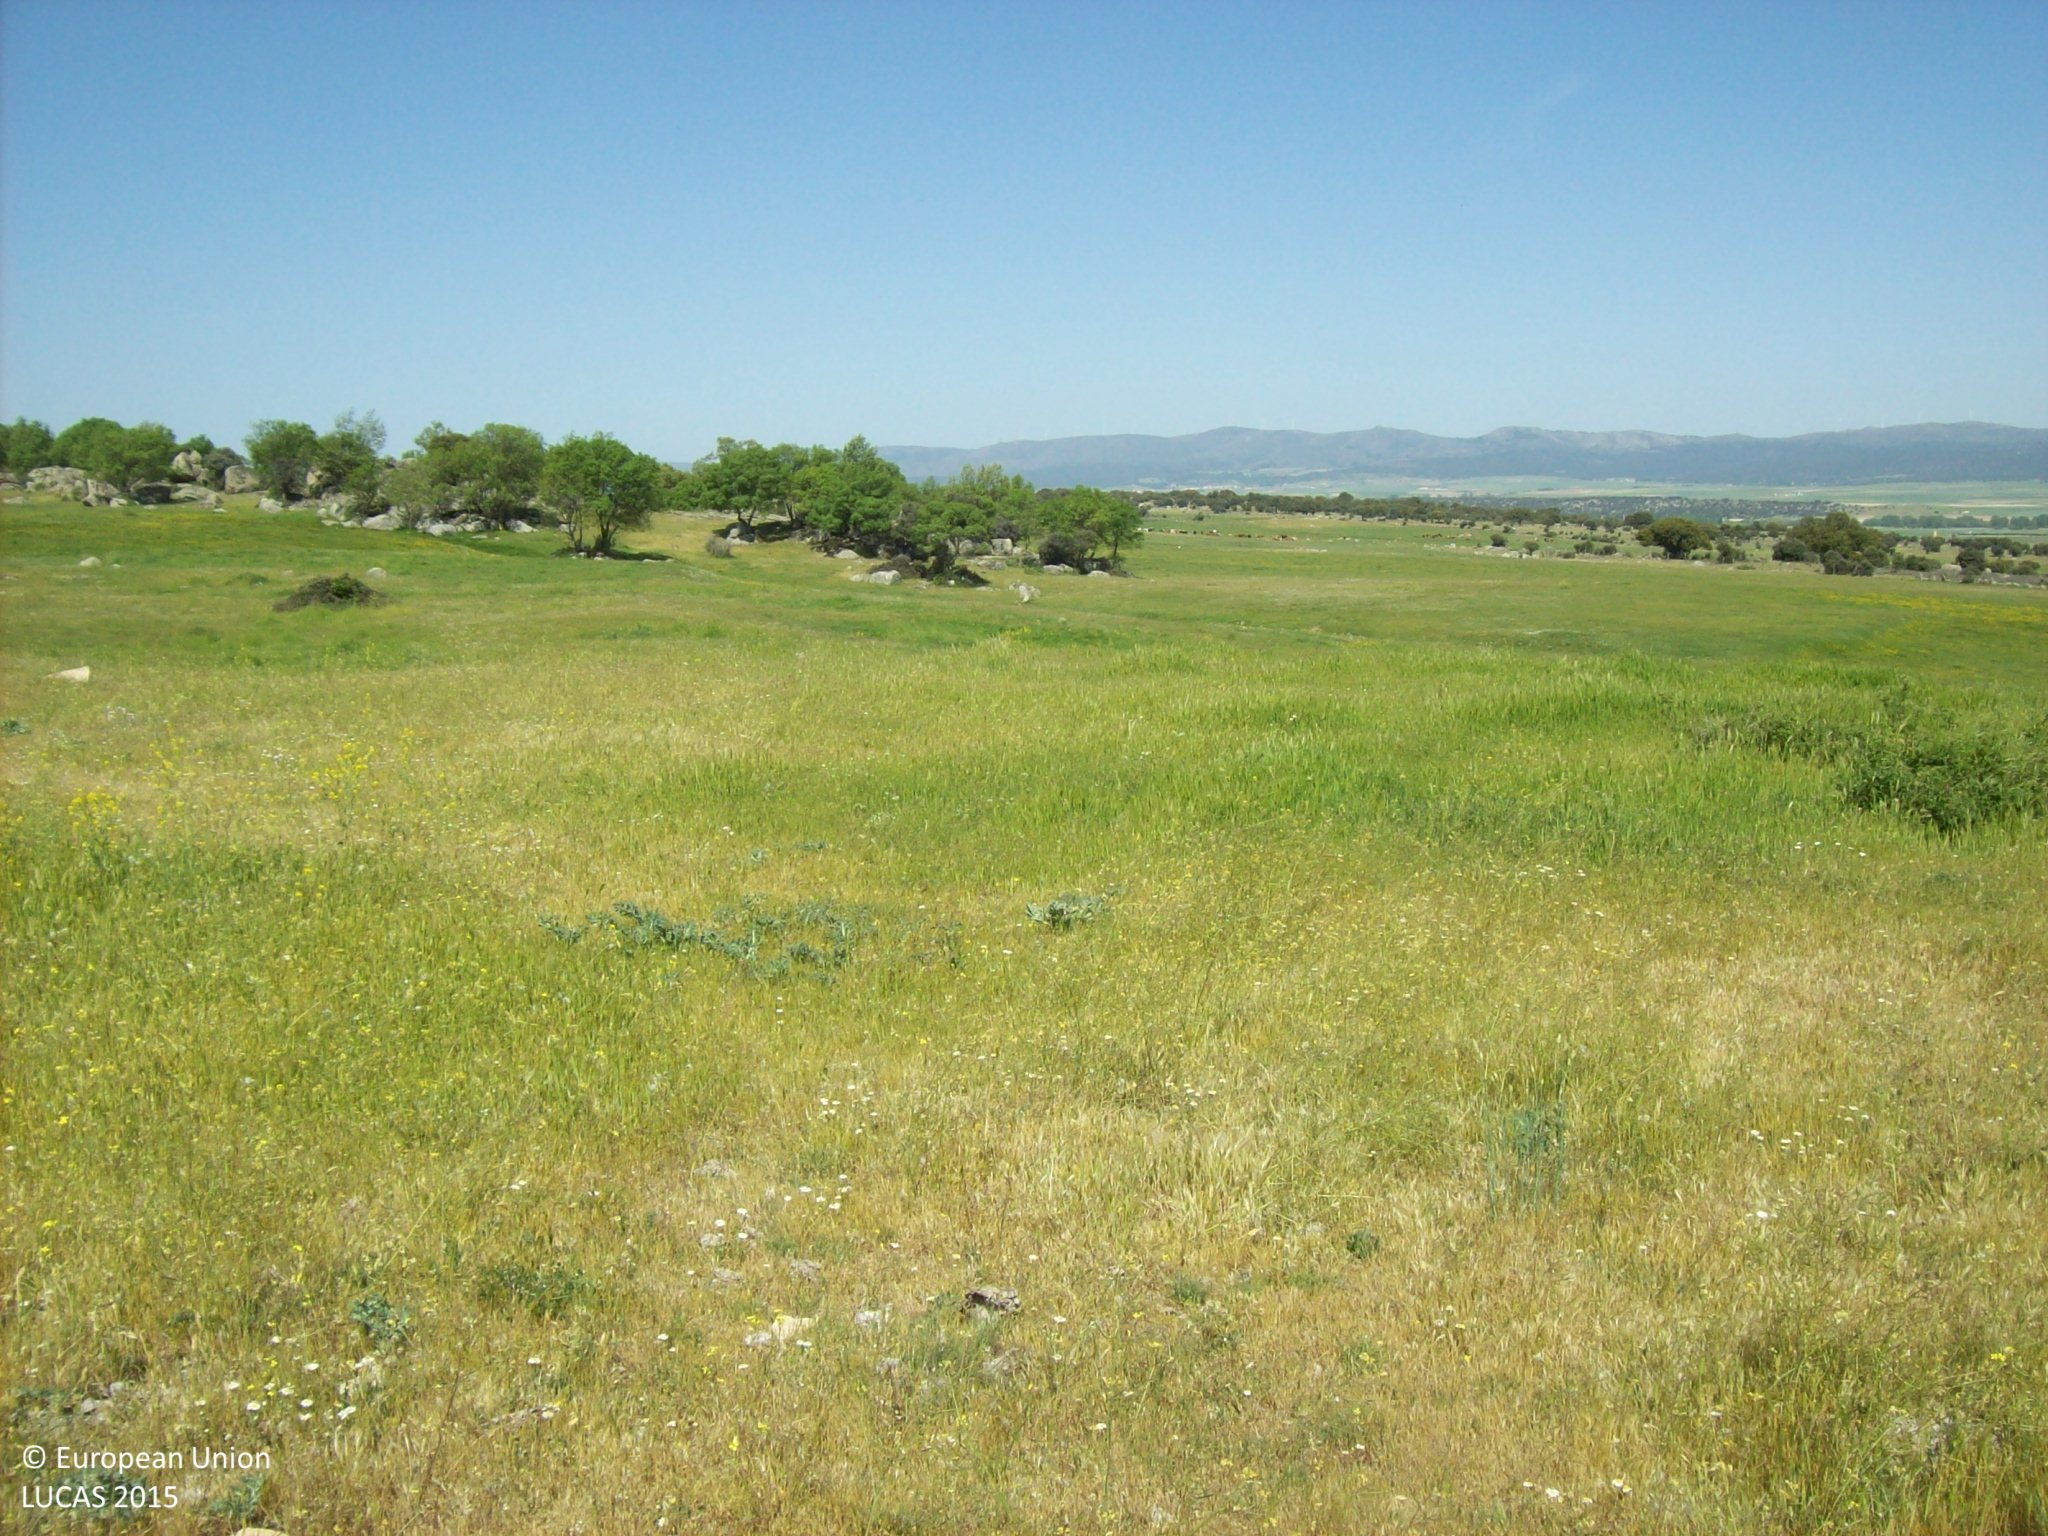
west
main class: Grassland
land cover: Grassland without tree/shrub cover
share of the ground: > 75 %
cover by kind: herbaceous plants 95 %, shrubs 5 %
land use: Agriculture (excluding fallow land and kitchen gardens)
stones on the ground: < 10 %
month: May
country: ES
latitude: 40.5399
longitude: -4.8743
